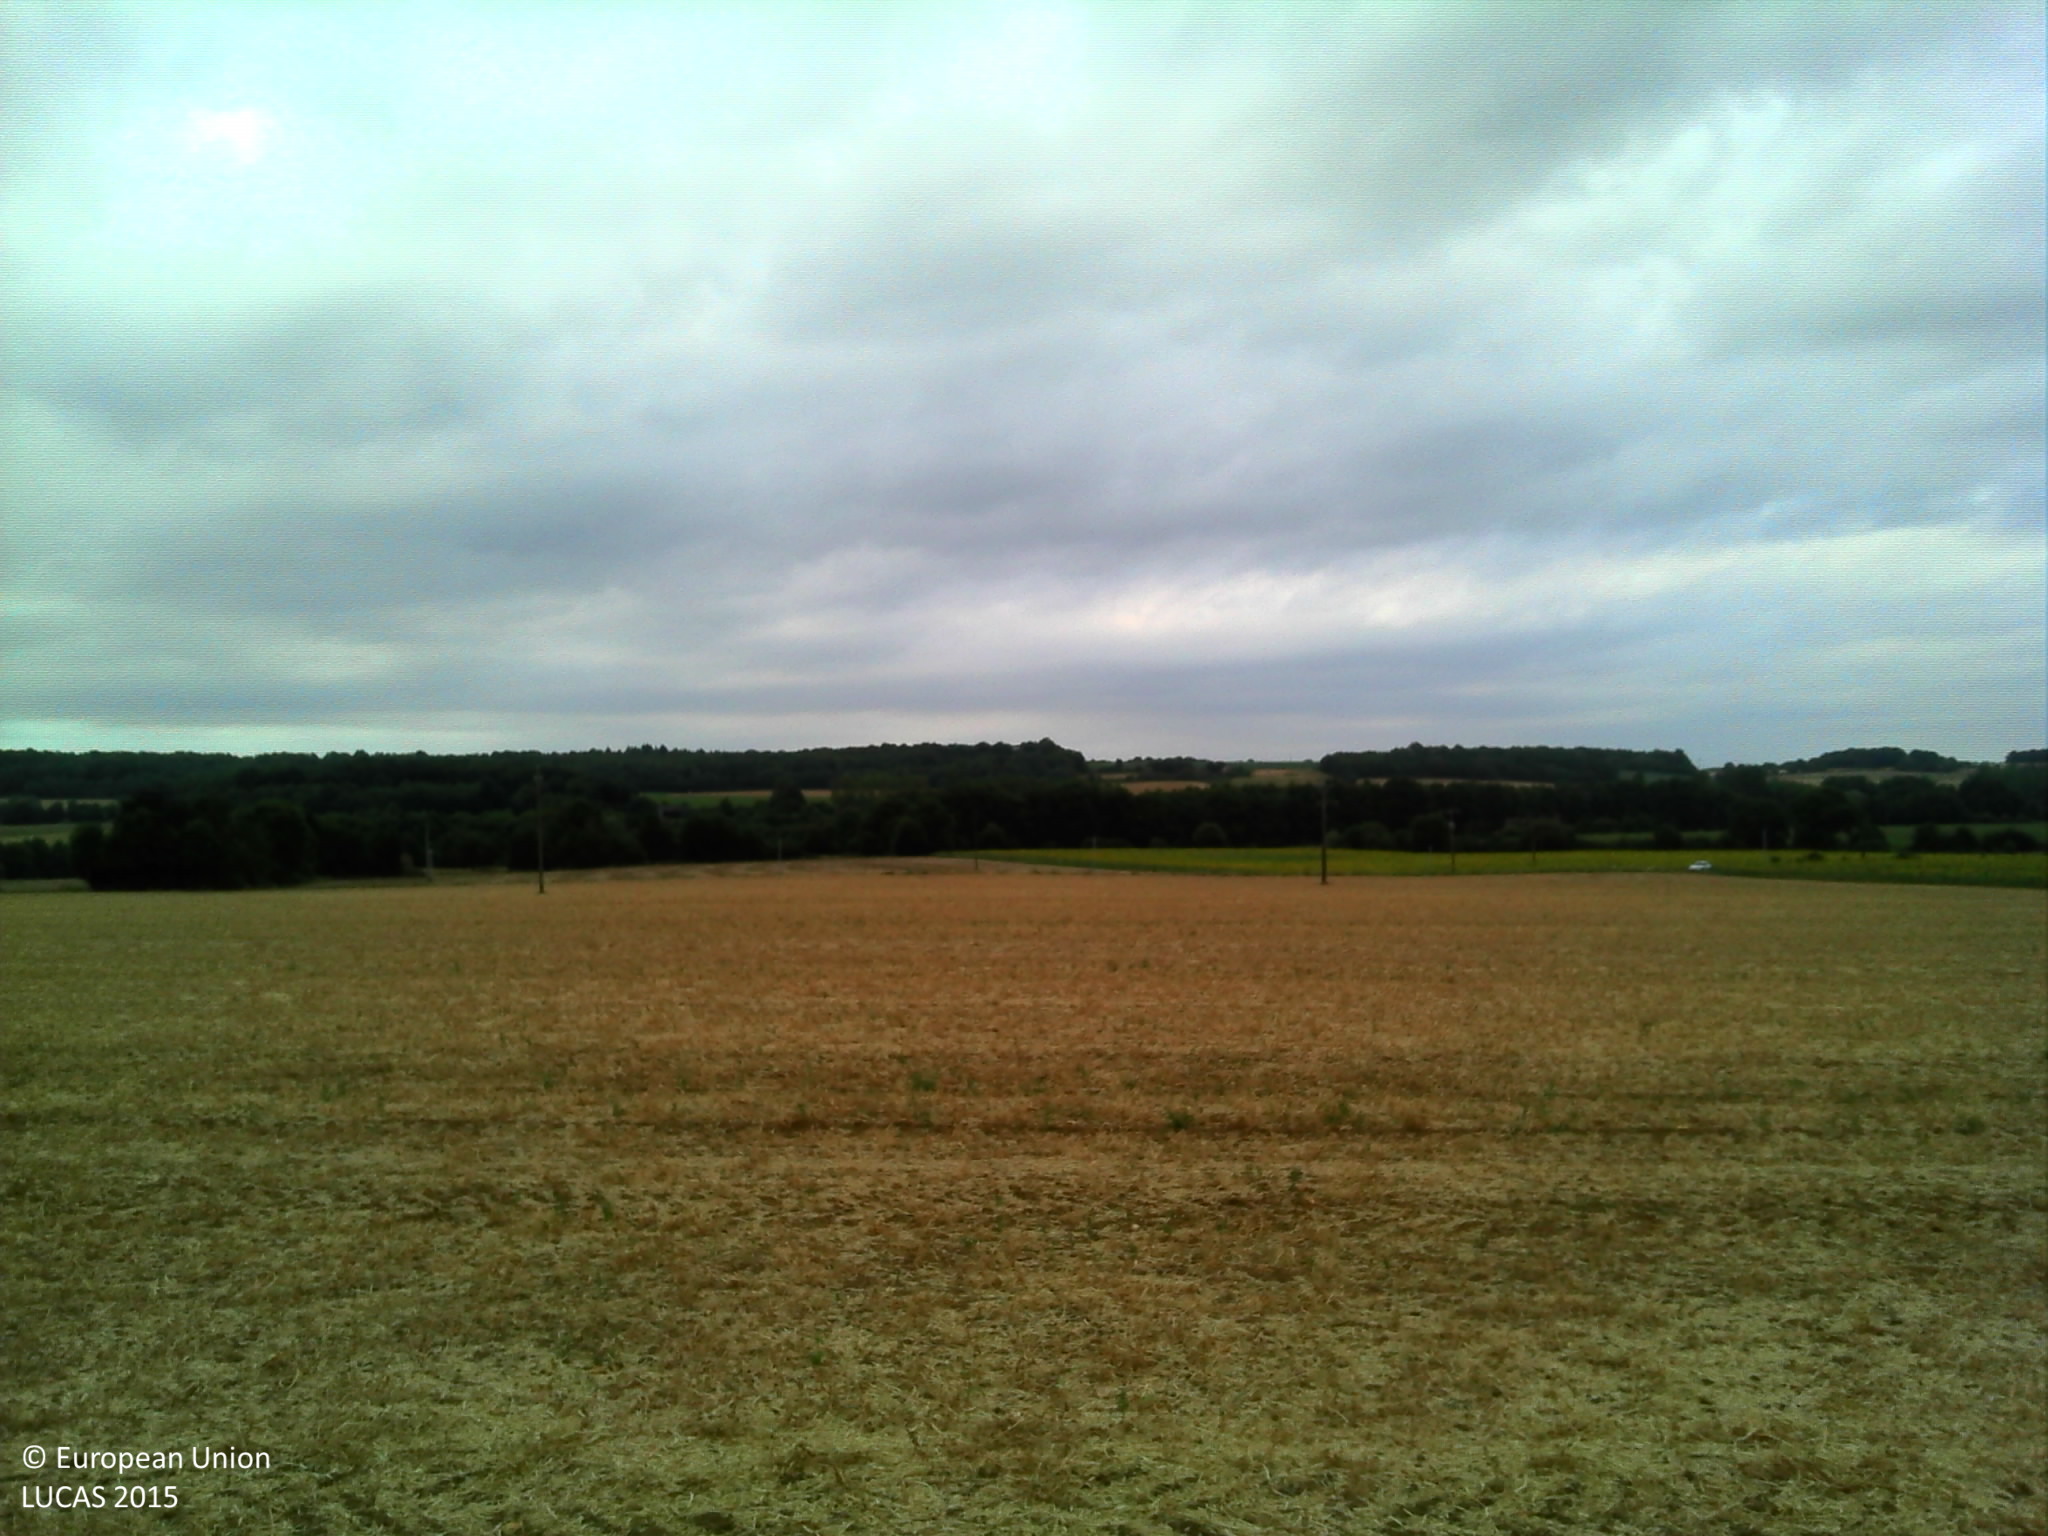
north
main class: Cropland
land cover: Rape and turnip rape
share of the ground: 25 - 50 %
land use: Agriculture (excluding fallow land and kitchen gardens)
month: July
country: FR
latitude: 47.9829
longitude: 0.5854
